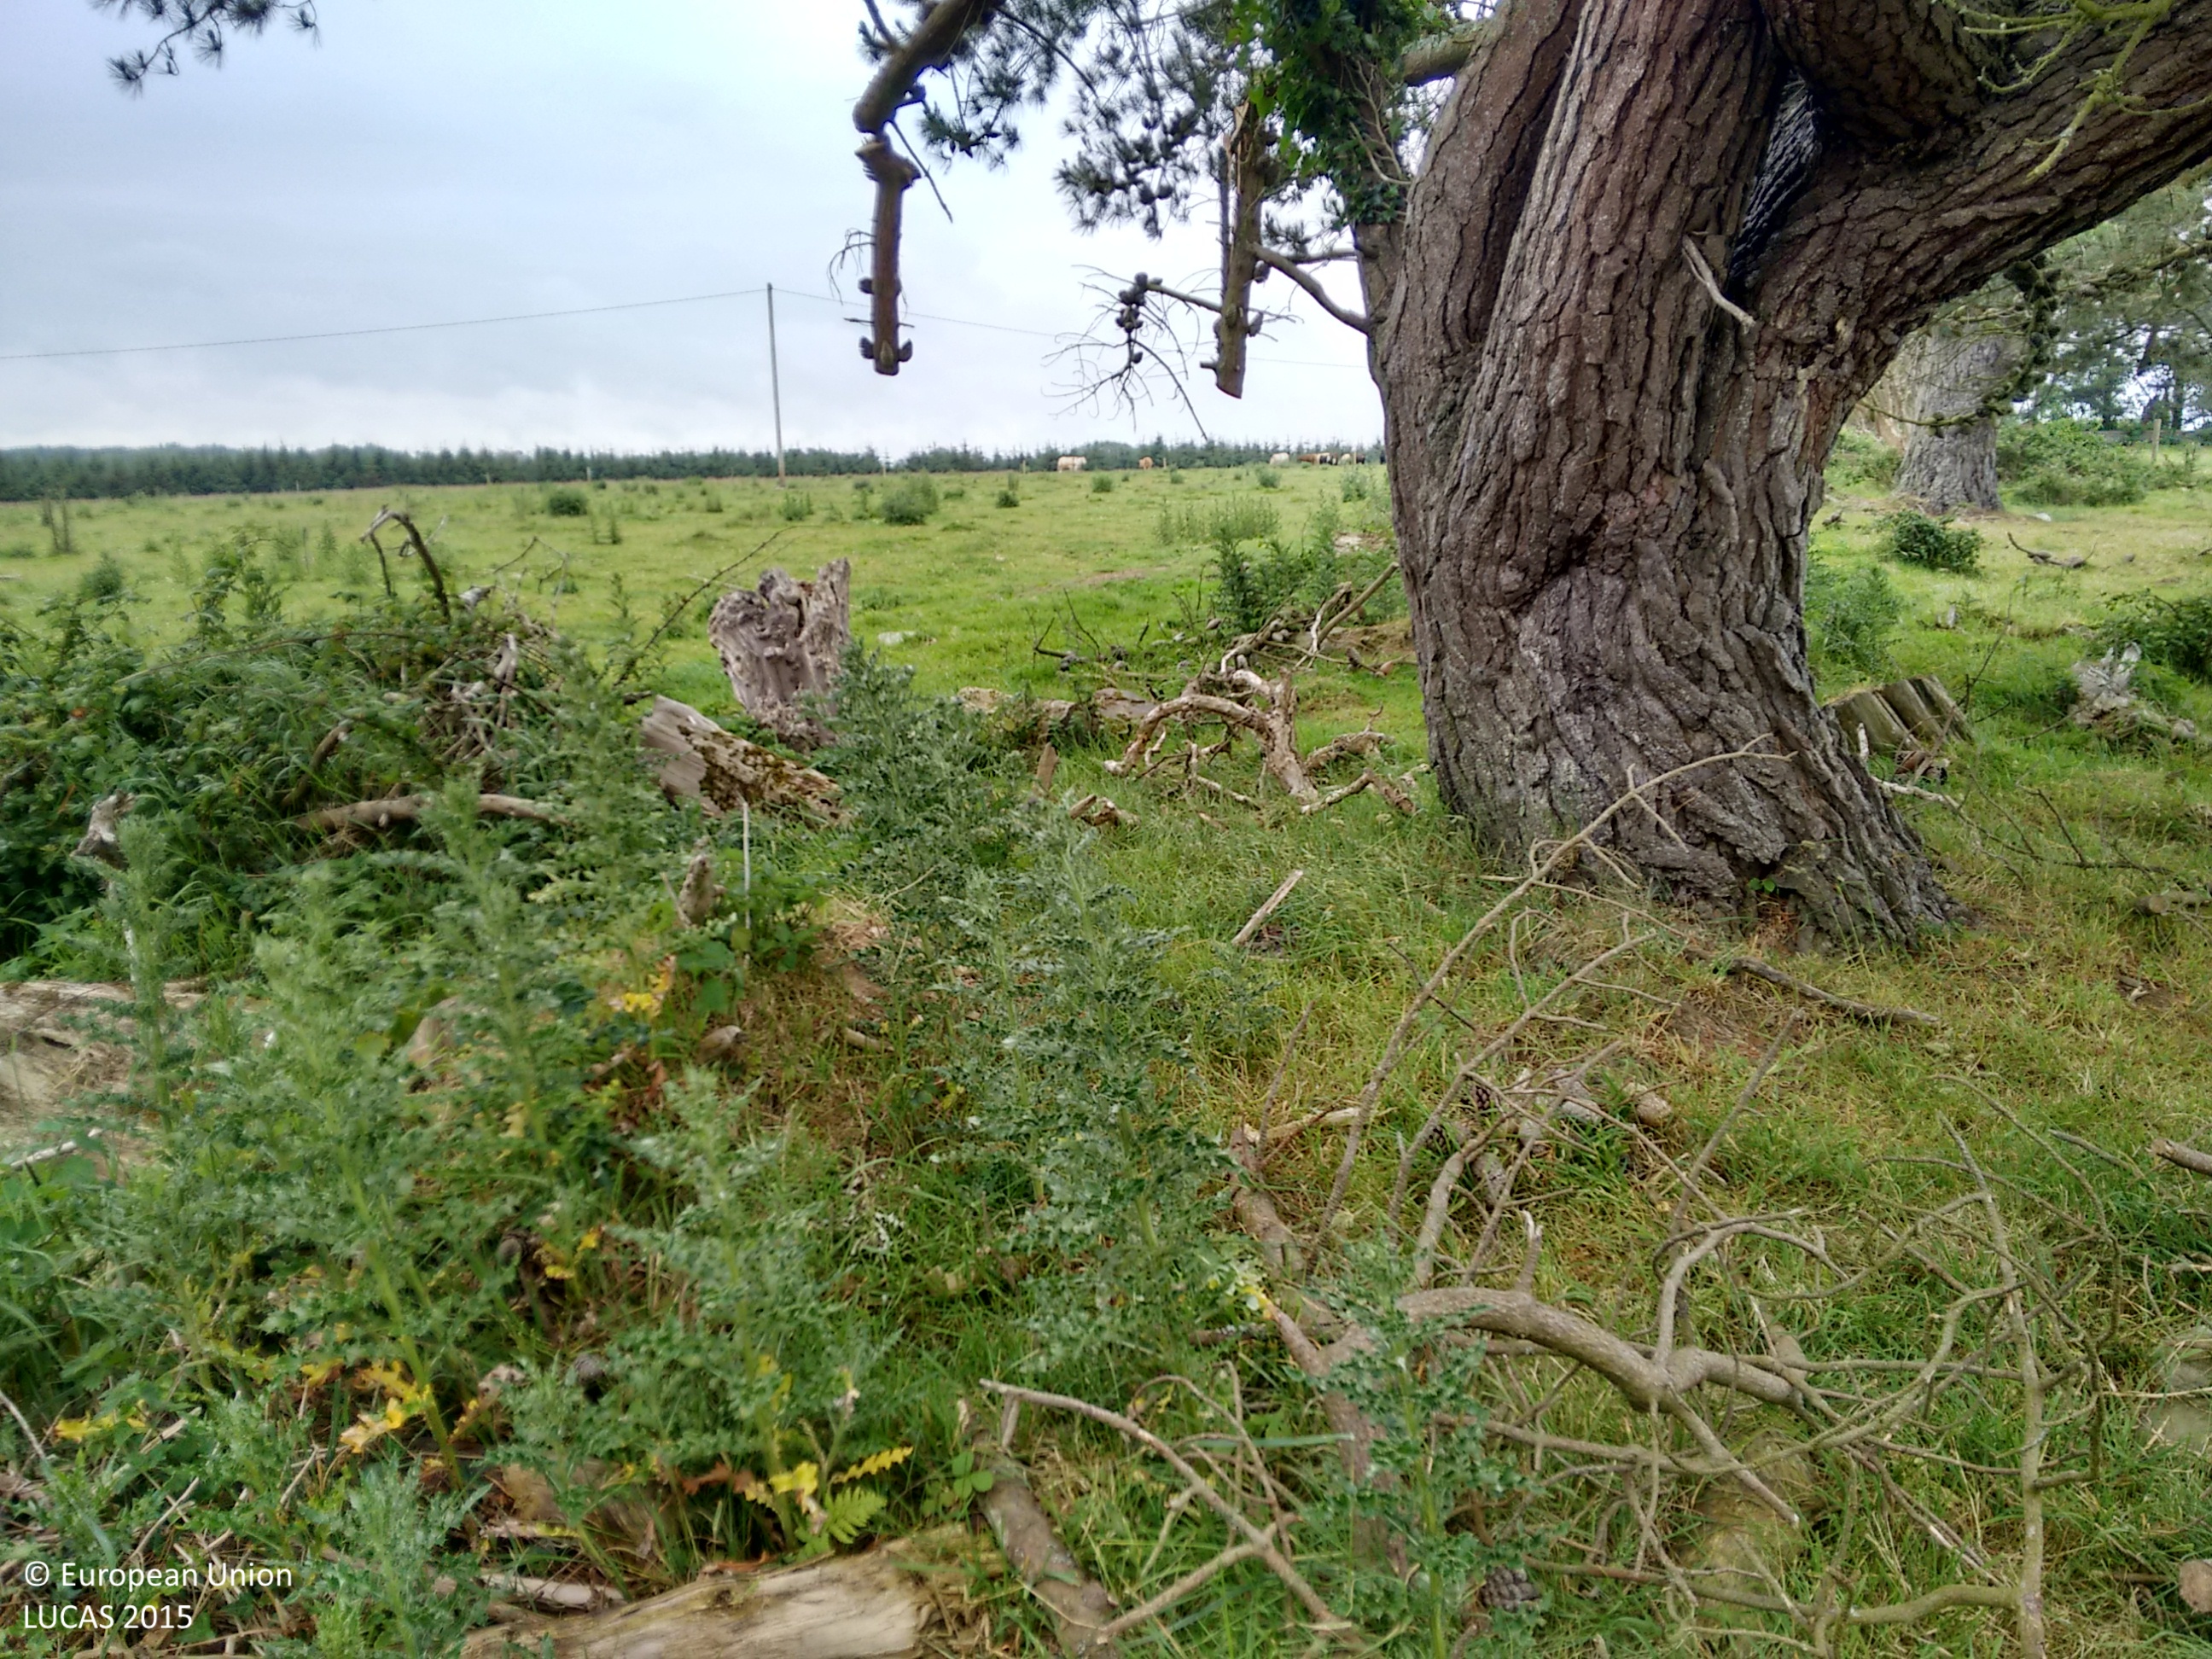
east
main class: Grassland
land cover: Grassland with sparse tree/shrub cover
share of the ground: > 75 %
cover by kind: herbaceous plants 95 %, coniferous forest trees 5 %
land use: Agriculture (excluding fallow land and kitchen gardens)
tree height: > 5 m
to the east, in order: Grassland with sparse tree/shrub cover; Grassland without tree/shrub cover; Electric lines; Grassland without tree/shrub cover; Fences; Grassland without tree/shrub cover; Fences; Other coniferous woodland
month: June
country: IE
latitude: 52.1904
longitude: -7.1001
